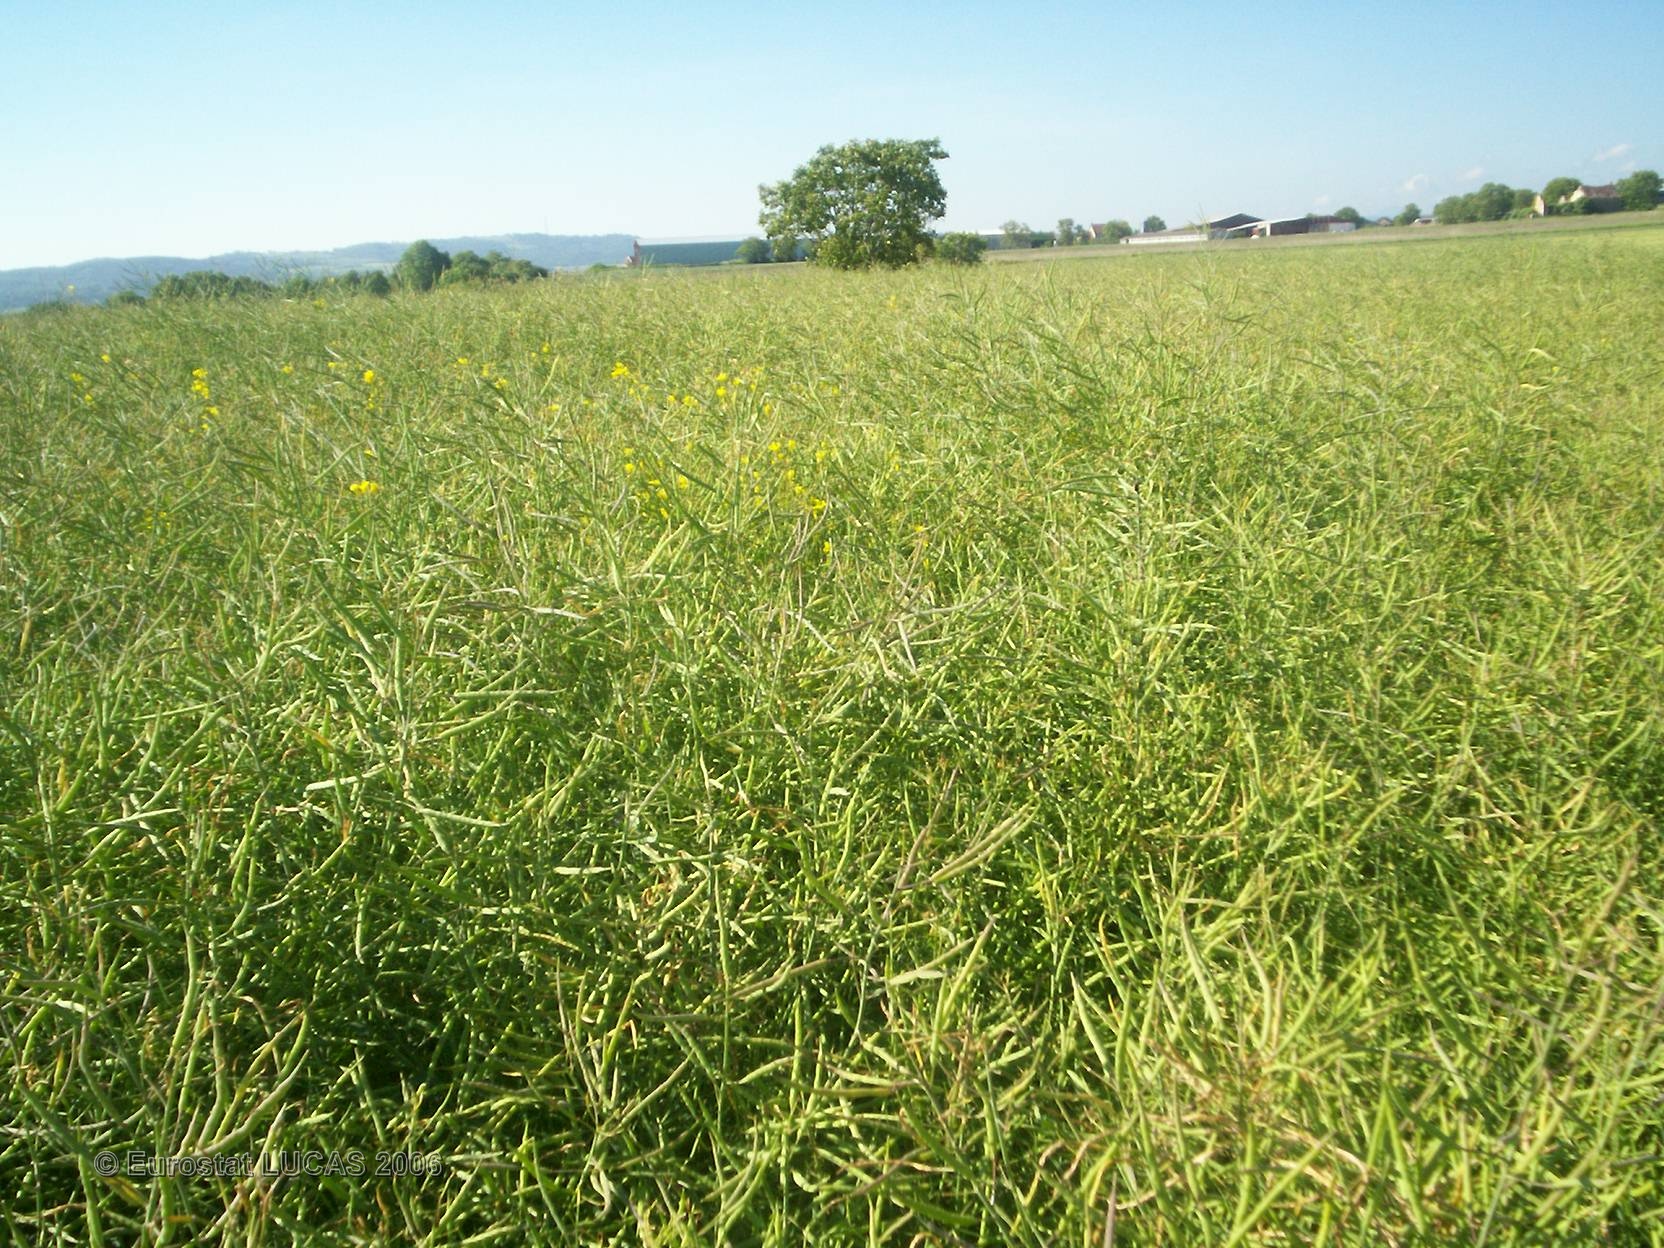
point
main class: Cropland
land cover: Rape and turnip rape
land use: Agriculture (excluding fallow land and kitchen gardens)
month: June
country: FR
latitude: 46.1266
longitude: 3.0746
